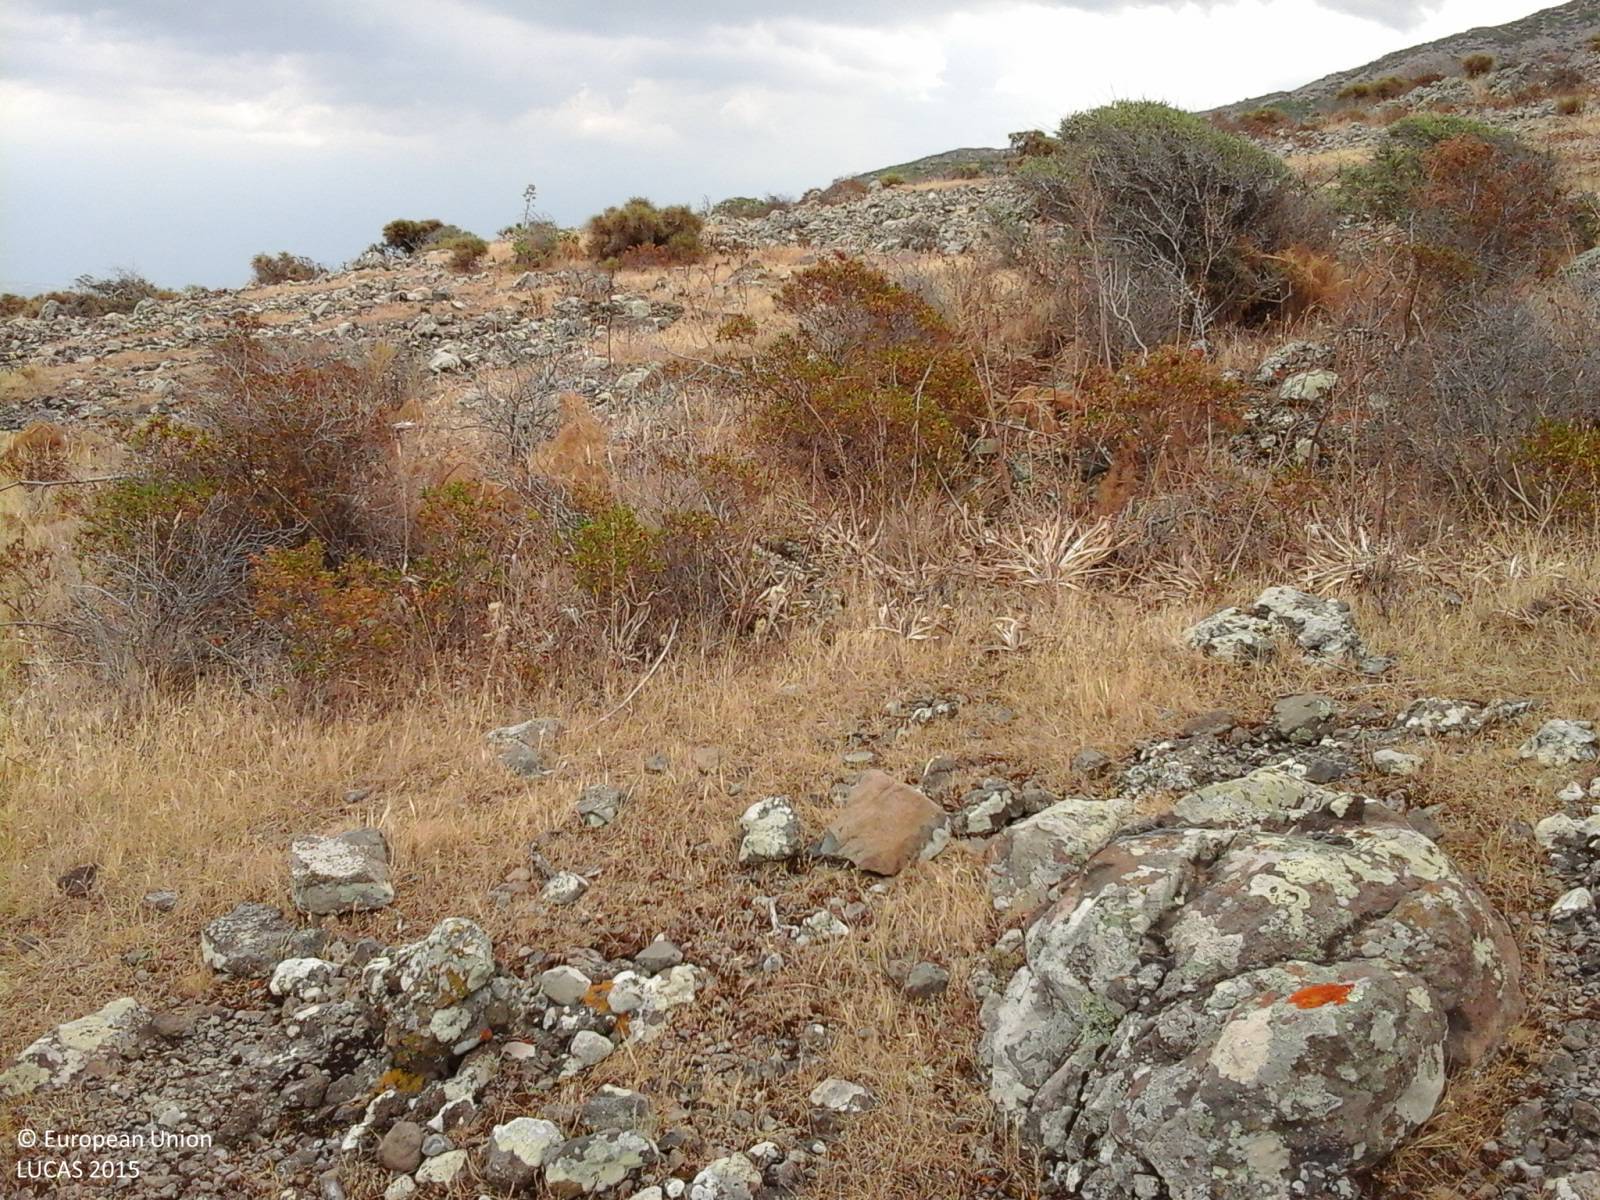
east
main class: Shrubland
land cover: Shrubland without tree cover
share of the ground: 50 - 75 %
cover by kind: consolidated bare surface 50 %, herbaceous plants 30 %, shrubs 20 %
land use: Semi-natural and natural areas not in use
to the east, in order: Shrubland without tree cover; Rocks and stones; Shrubland without tree cover; Rocks and stones; Shrubland without tree cover; Rocks and stones; Shrubland without tree cover; Rocks and stones; Shrubland without tree cover
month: June
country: IT
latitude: 39.6771
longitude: 8.5510
